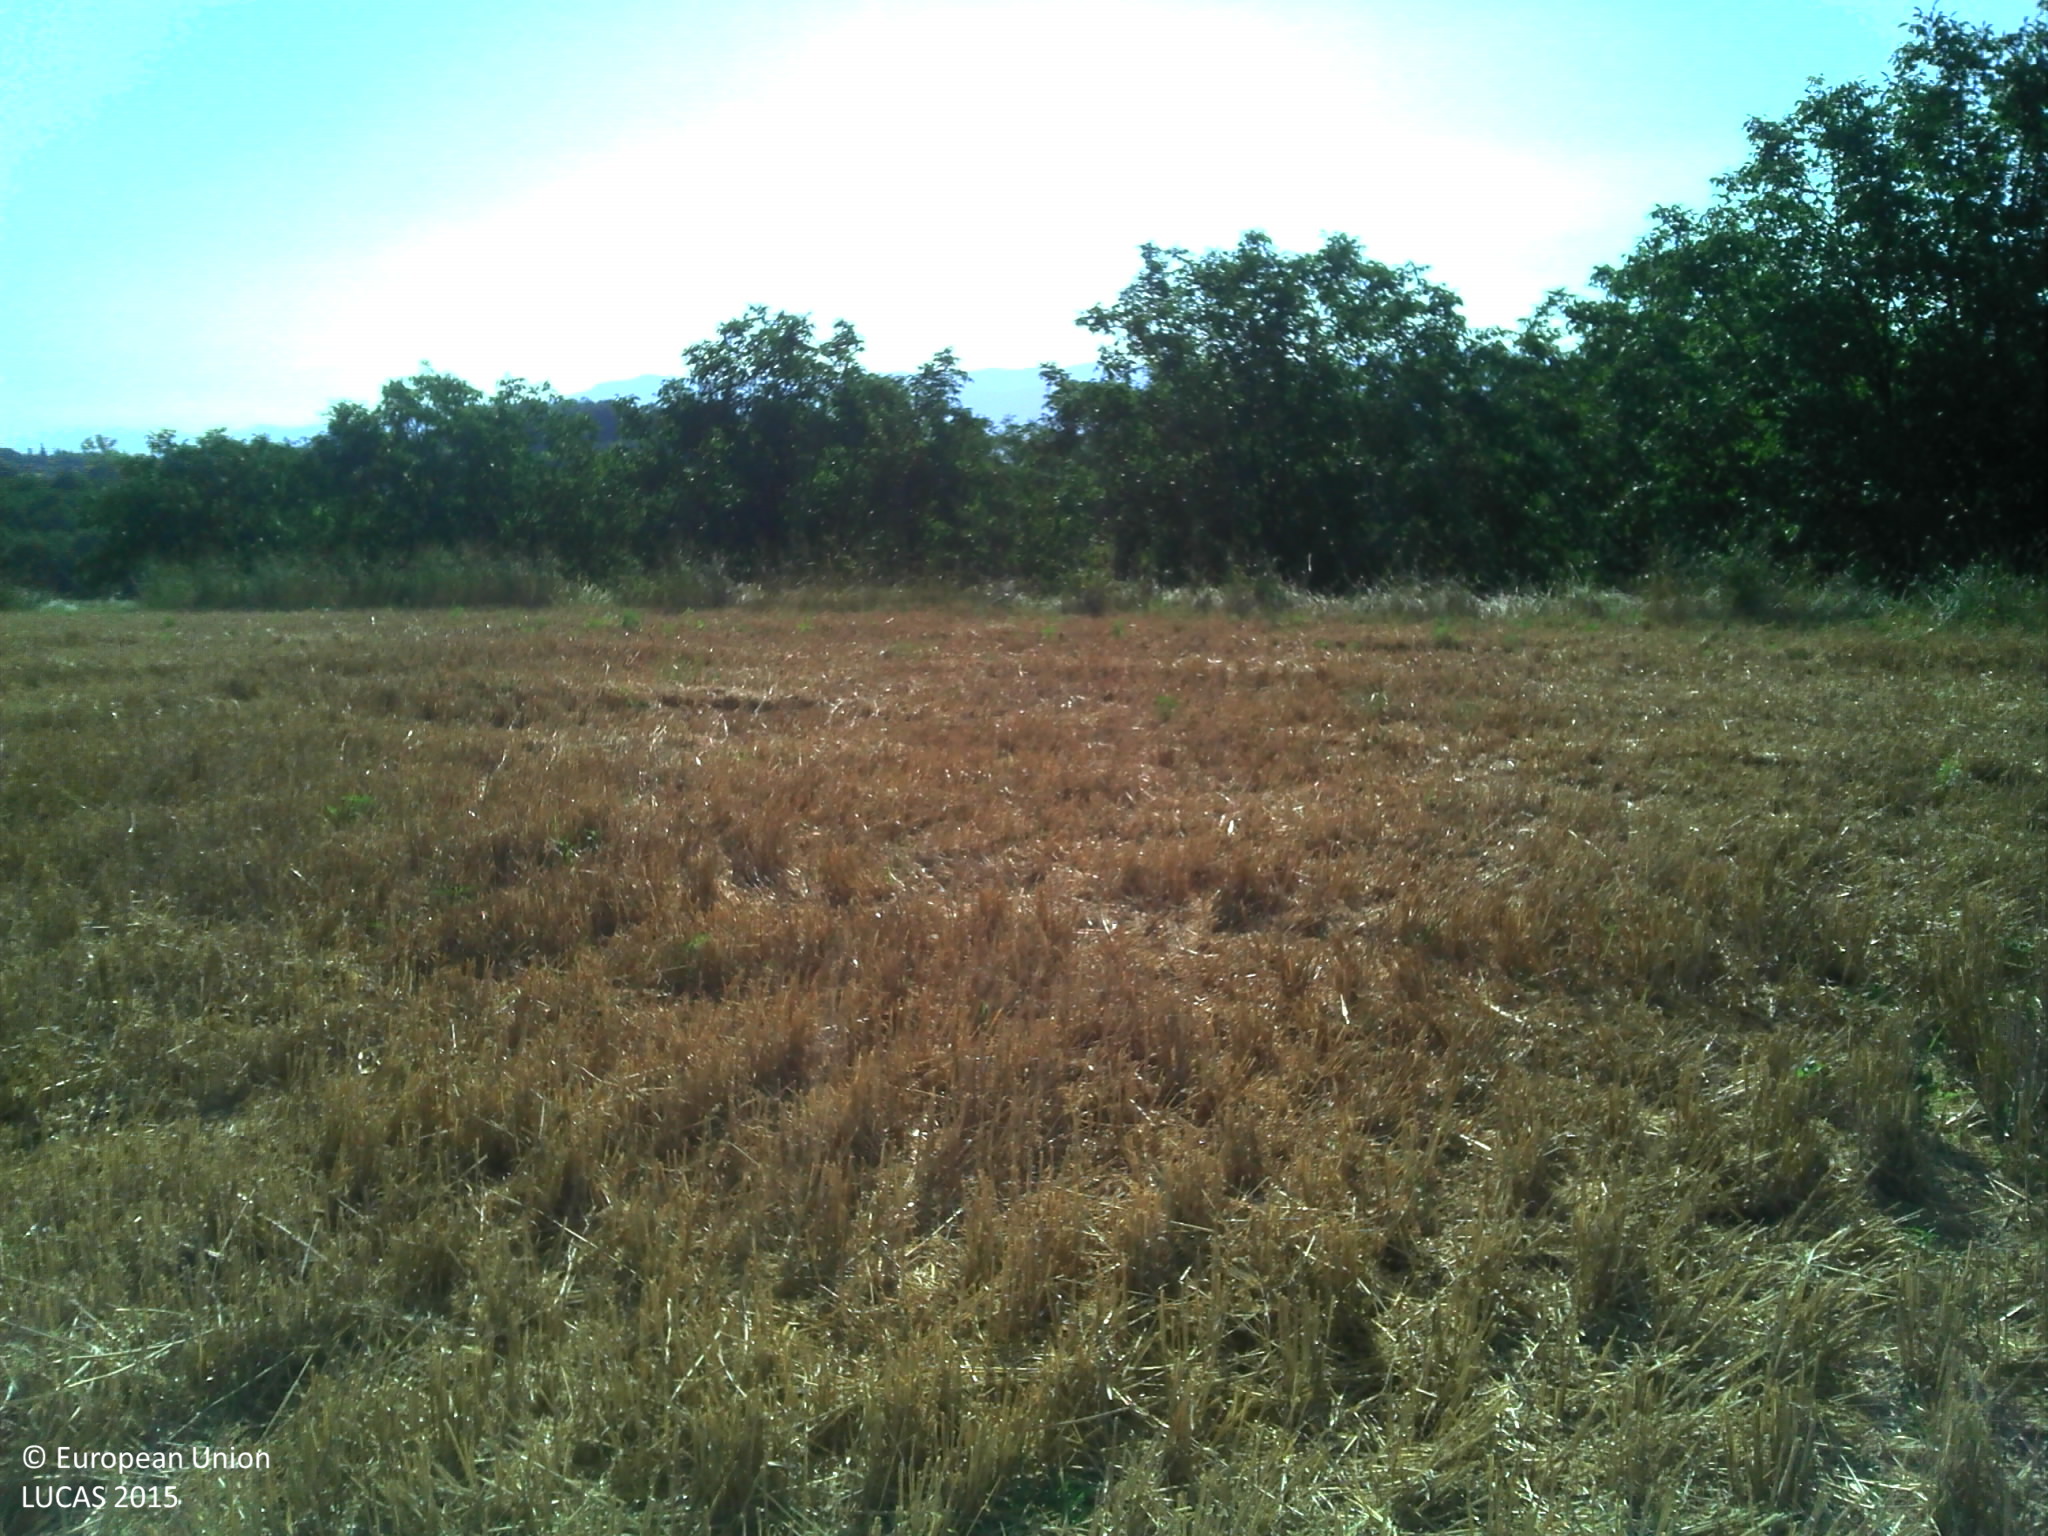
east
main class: Cropland
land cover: Durum wheat
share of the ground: > 75 %
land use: Agriculture (excluding fallow land and kitchen gardens)
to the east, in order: Durum wheat; Grass margins; Paved roads, cycling and walking lanes; Nuts trees; Grassland with sparse tree/shrub cover; Nuts trees; Tracks; Grass margins; Maize; Grass margins; Durum wheat
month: July
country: FR
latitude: 45.1071
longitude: 5.2139
